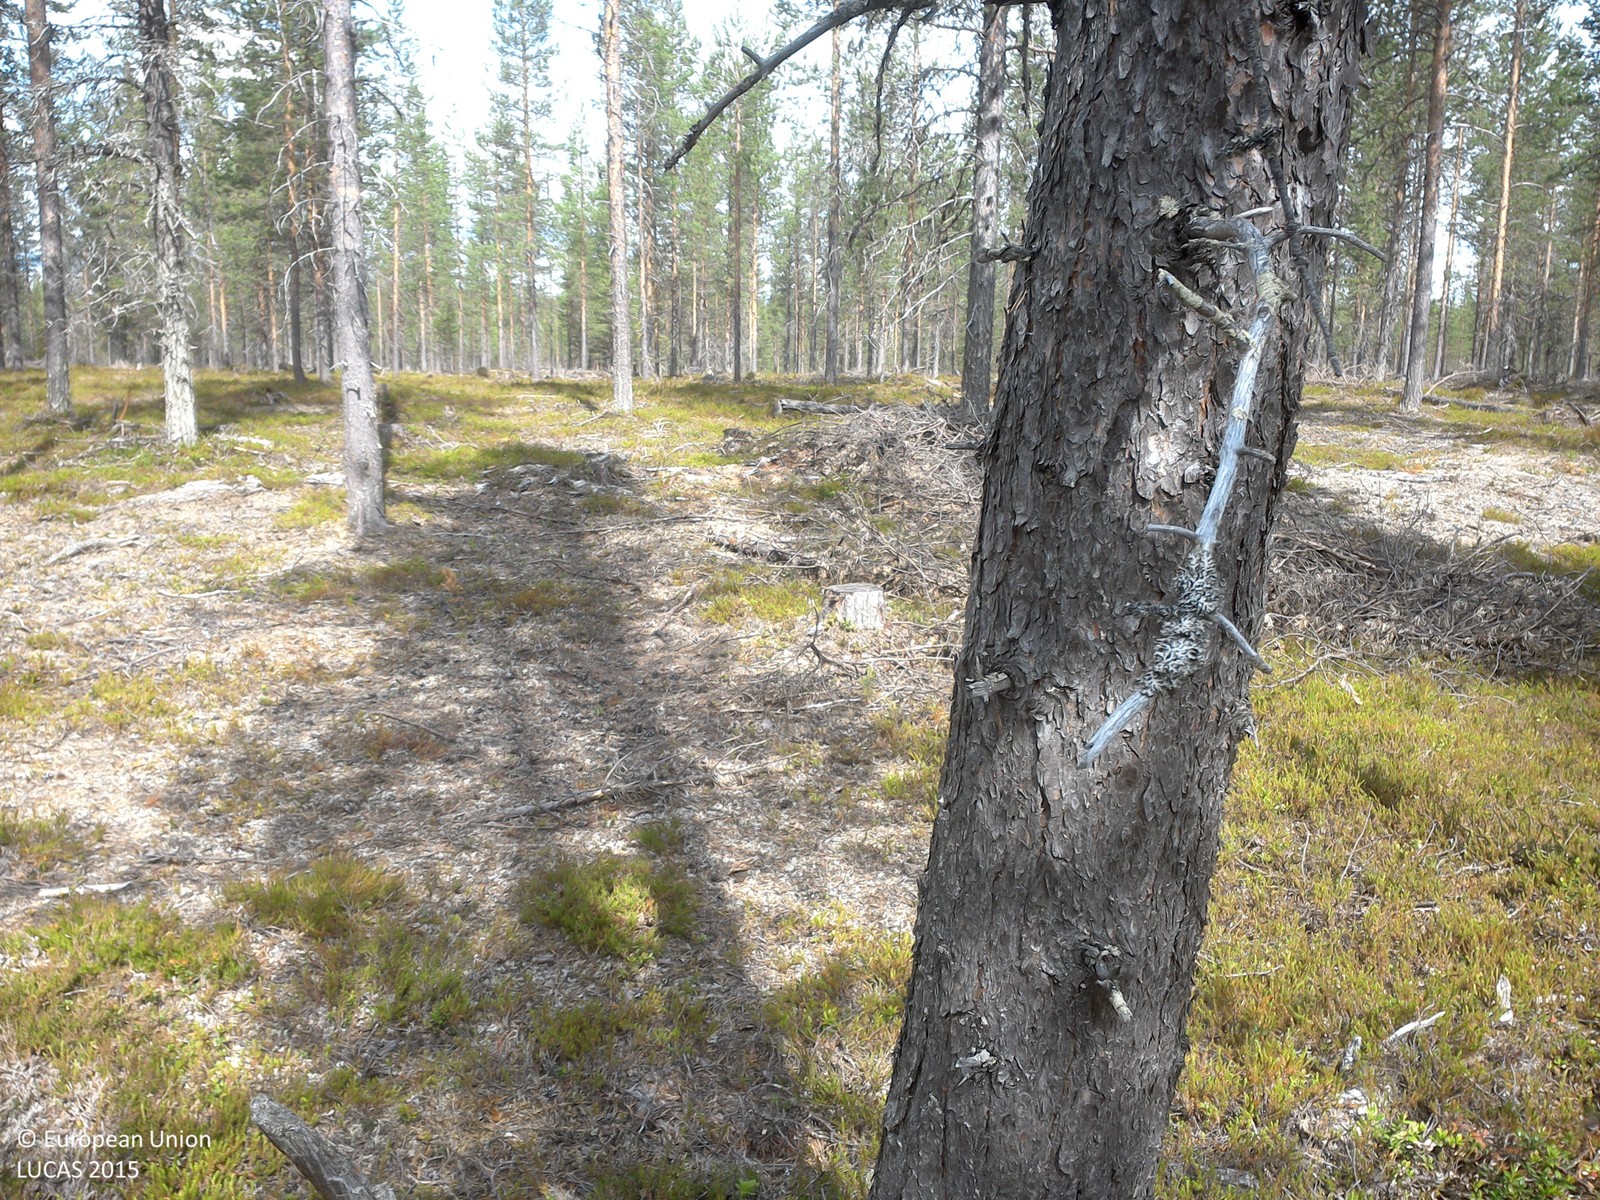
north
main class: Woodland
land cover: Pine dominated coniferous woodland
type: boreal forest
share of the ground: 10 - 25 %
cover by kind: shrubs 40 %, lichens and mosses 40 %, coniferous forest trees 20 %
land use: Forestry
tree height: > 5 m
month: July
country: SE
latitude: 67.5129
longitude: 23.3450
